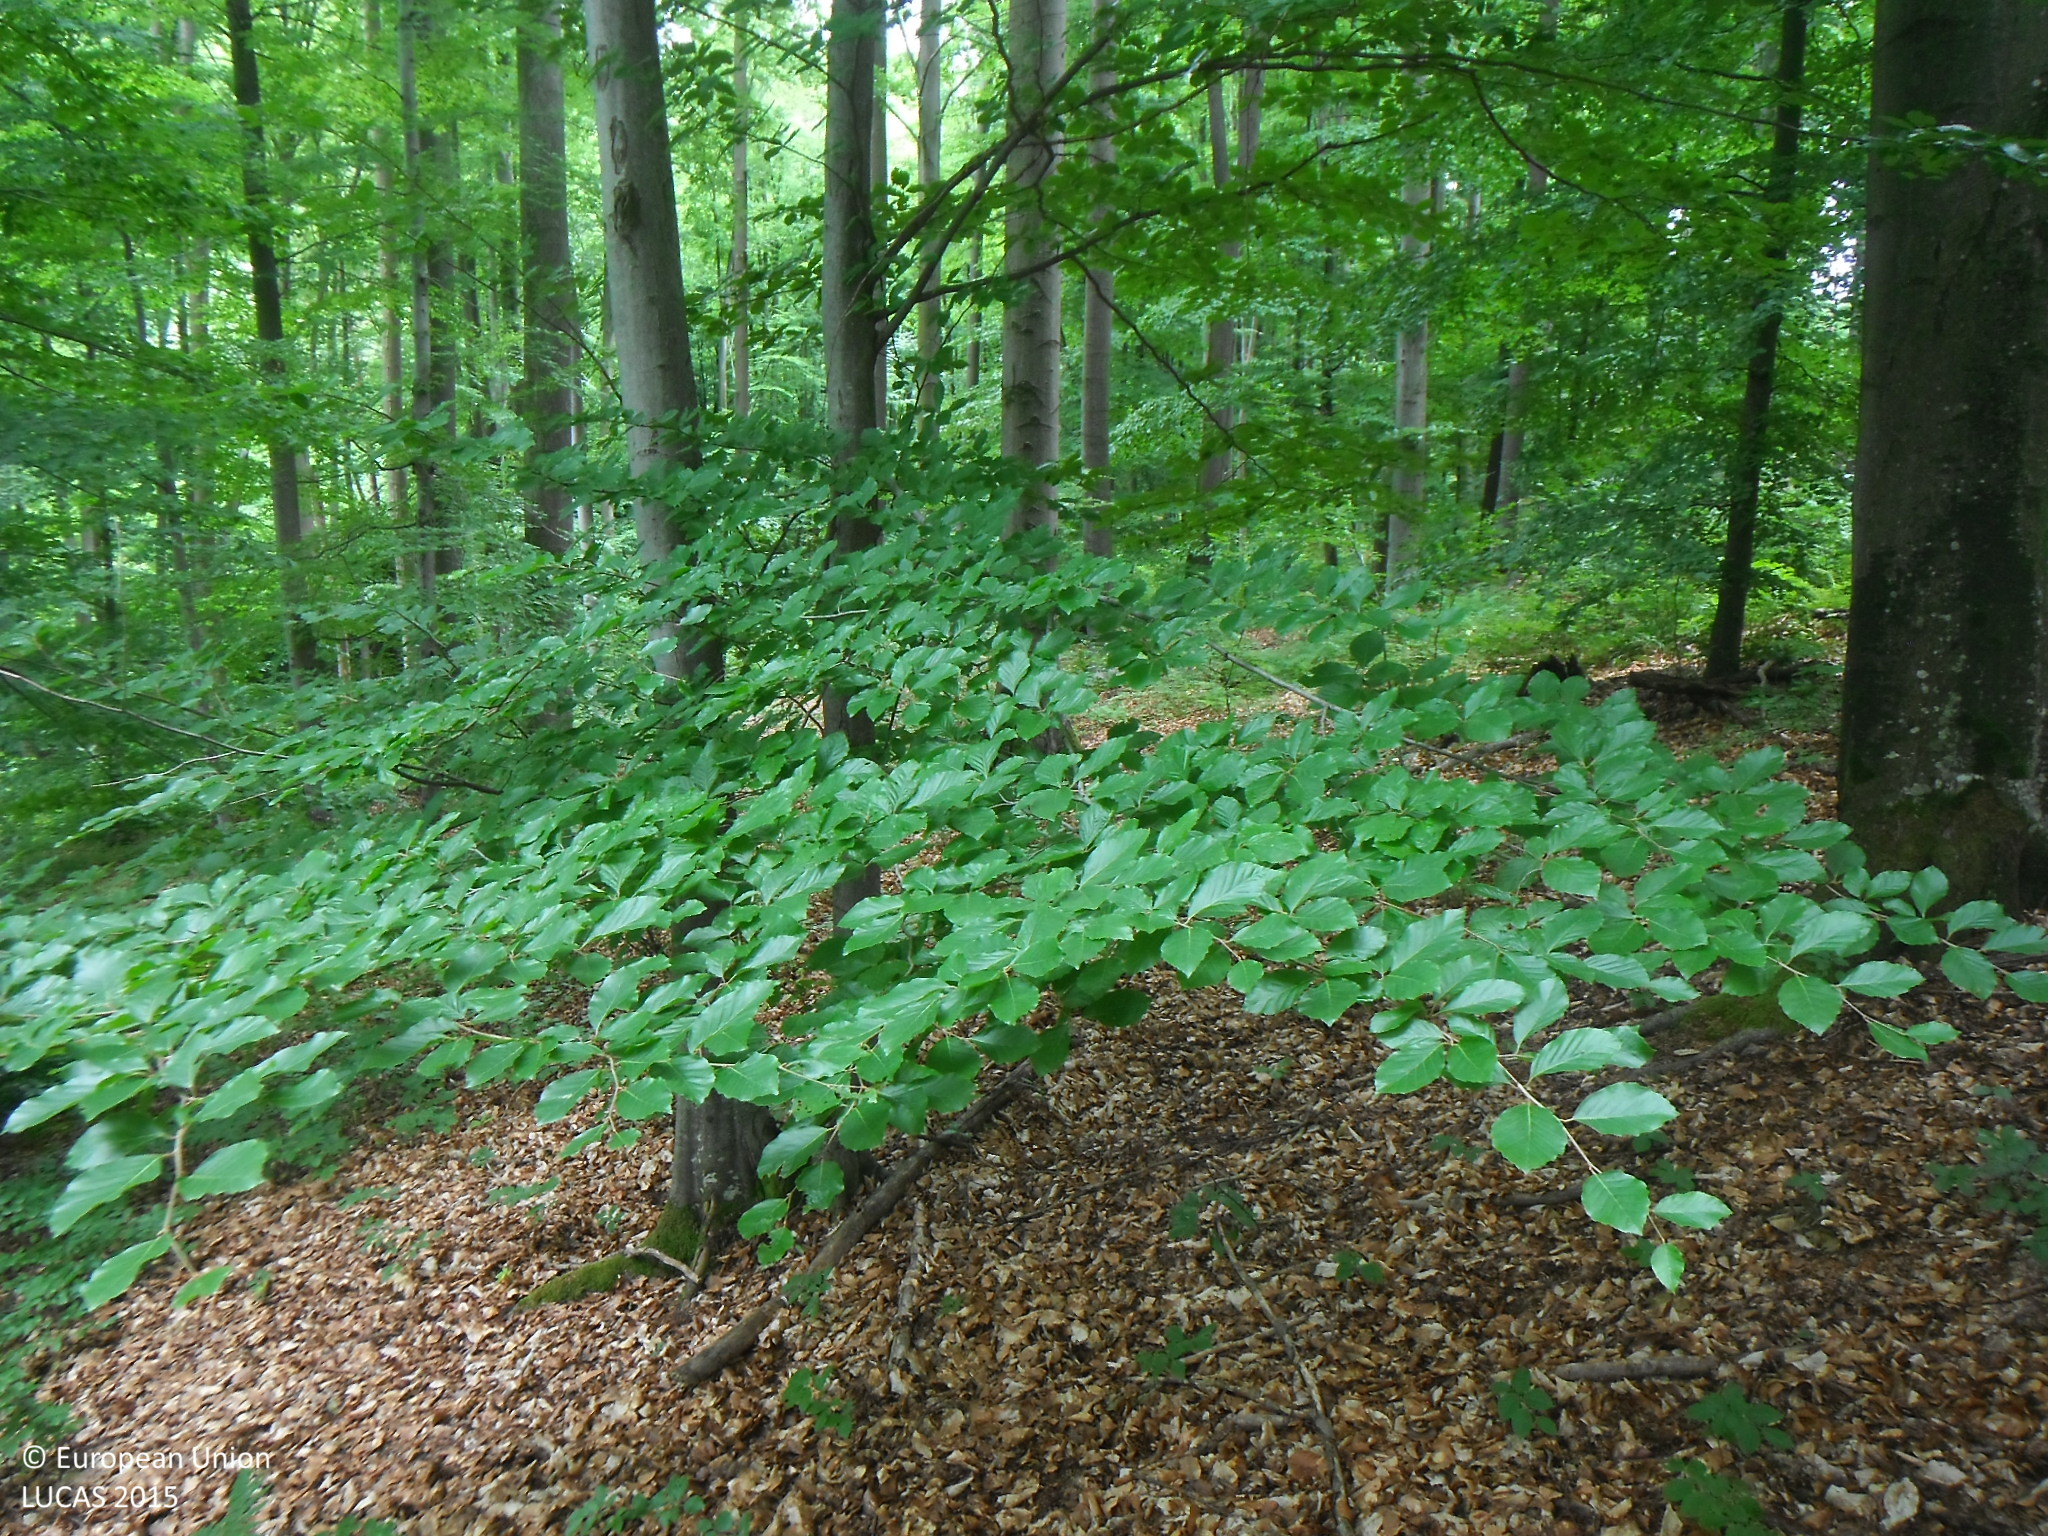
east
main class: Woodland
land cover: Broadleaved woodland
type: beech forest
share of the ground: > 75 %
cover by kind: broadleaved forest trees 80 %, herbaceous plants 15 %, lichens and mosses 5 %
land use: Forestry
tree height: > 5 m
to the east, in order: Broadleaved woodland; Rivers and streams; Broadleaved woodland; Grass margins; Paved roads, cycling and walking lanes; Grass margins; Ditches and canals; Broadleaved woodland
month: June
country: SK
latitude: 49.0565
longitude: 22.0021
